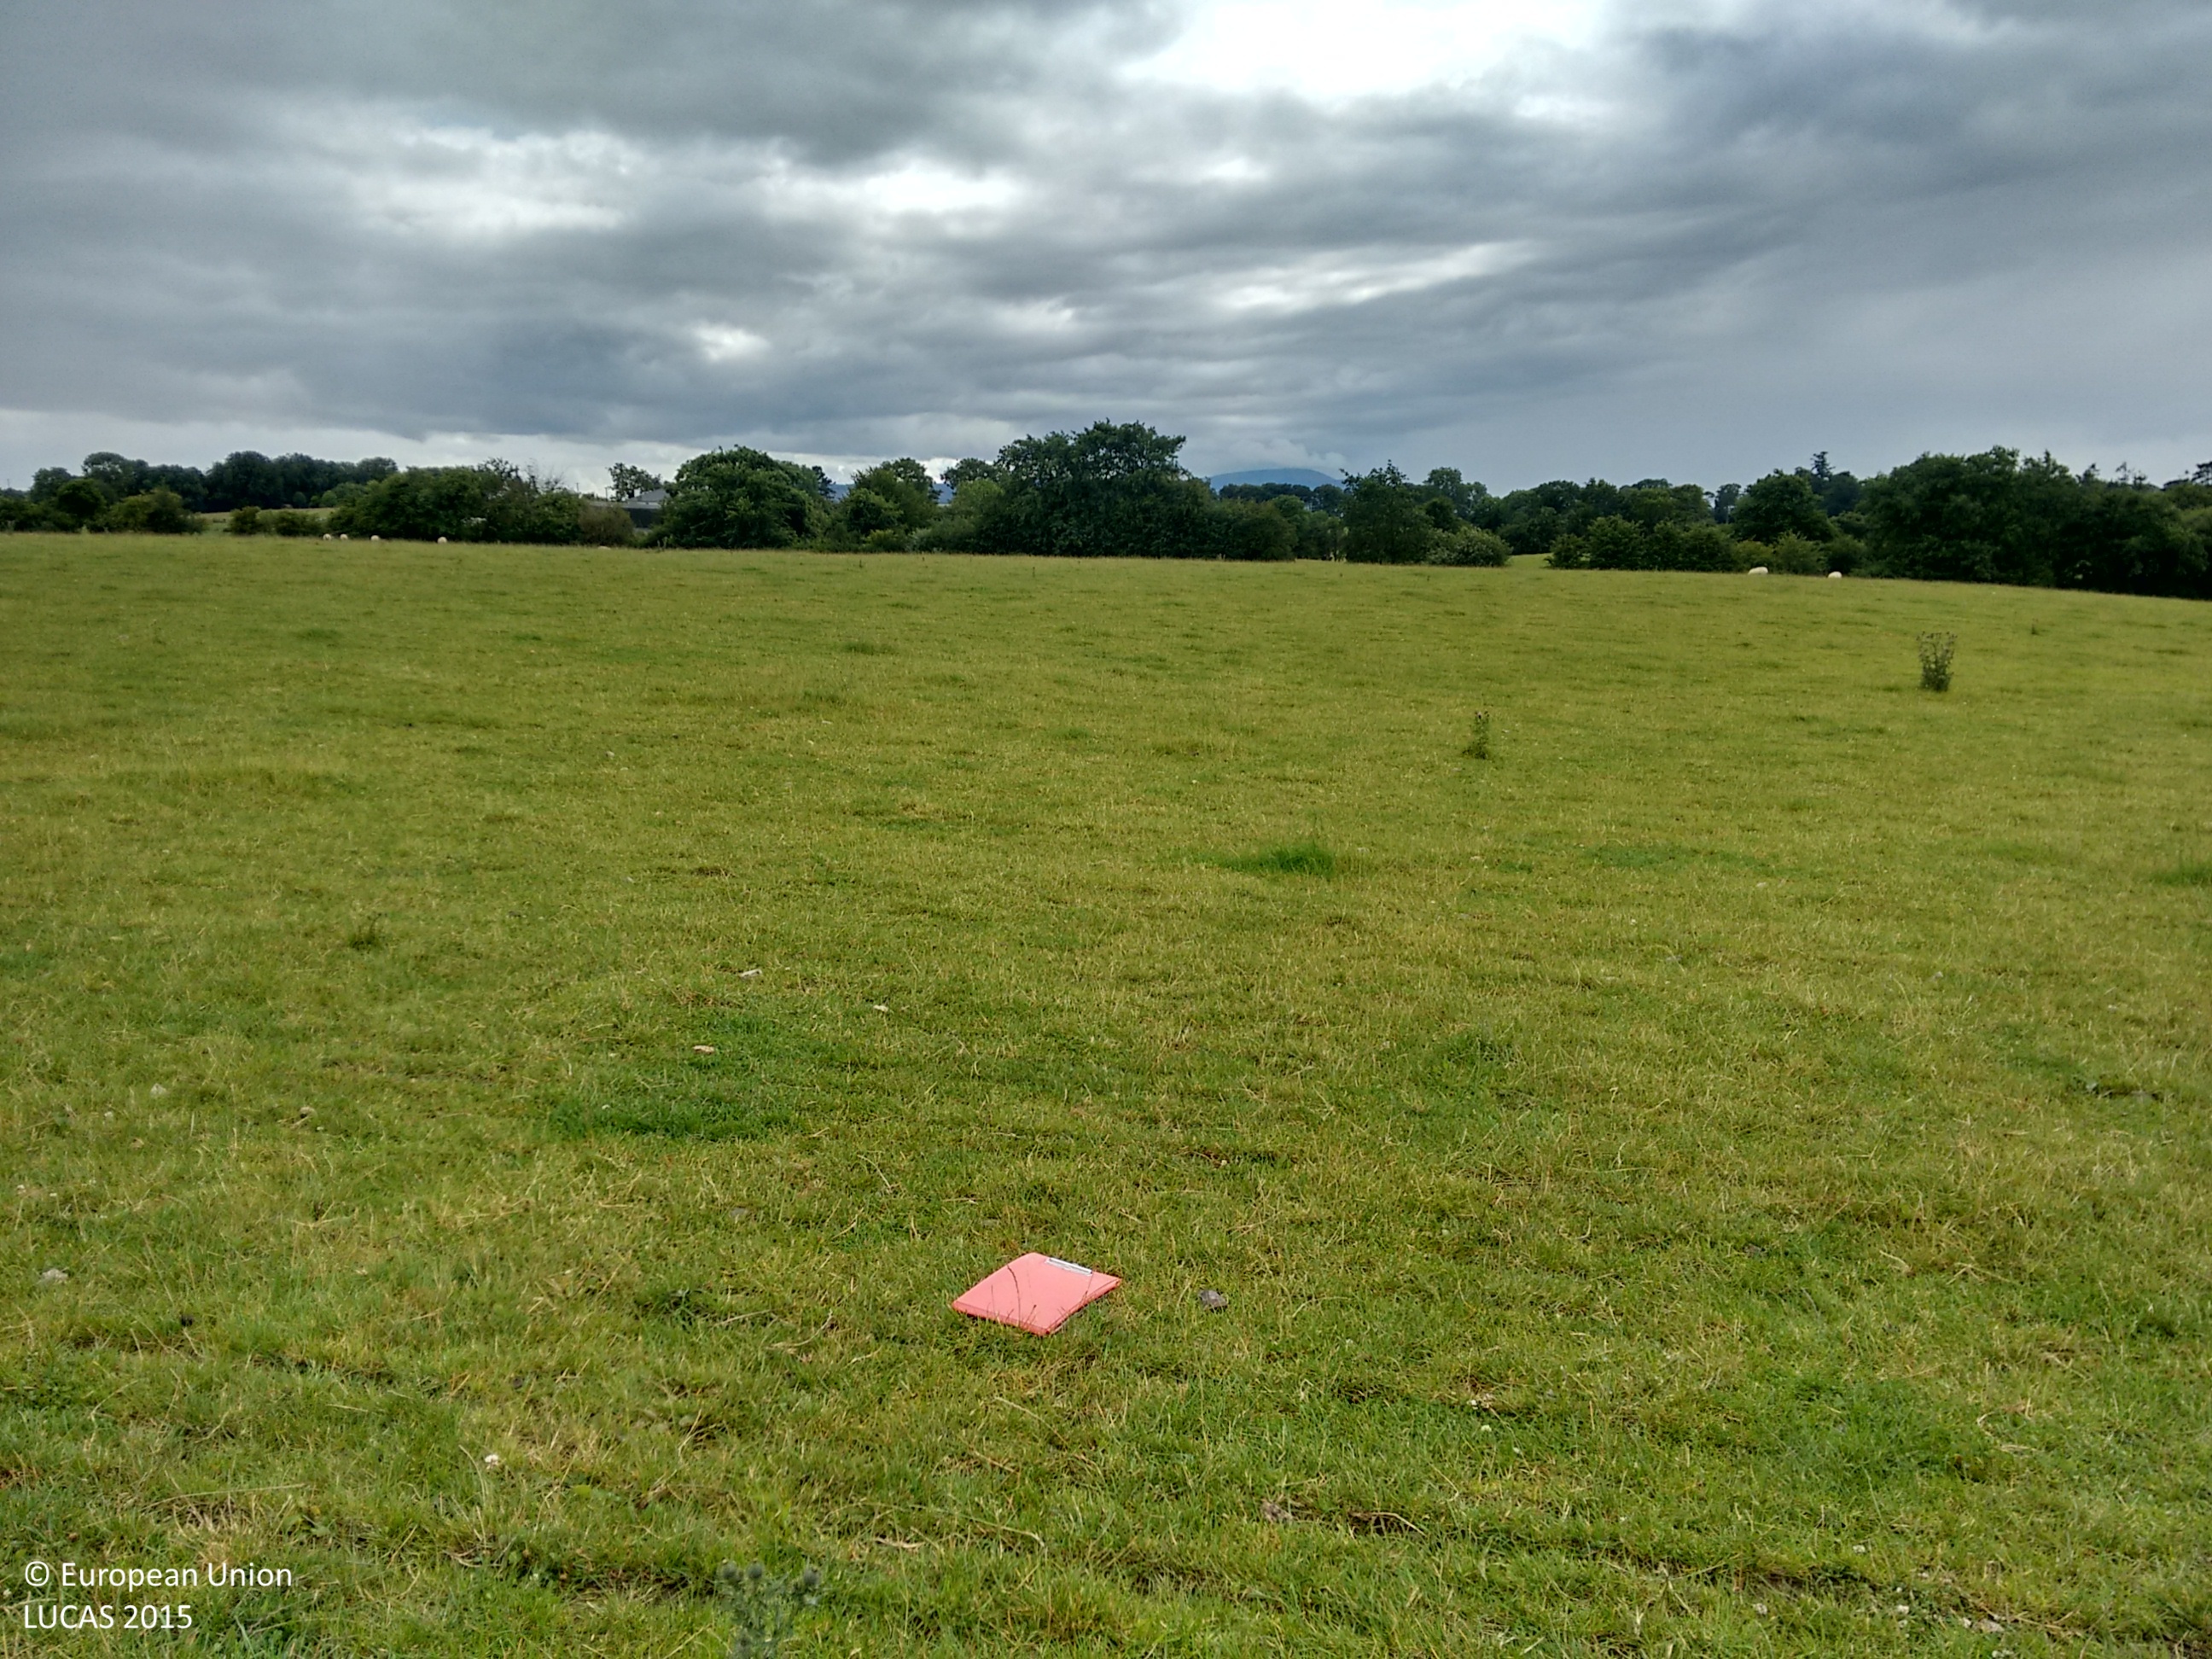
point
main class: Grassland
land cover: Grassland without tree/shrub cover
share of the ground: > 75 %
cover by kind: herbaceous plants 95 %, unconsolidated bare surface 5 %
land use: Agriculture (excluding fallow land and kitchen gardens)
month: July
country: IE
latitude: 52.7609
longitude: -6.7162
